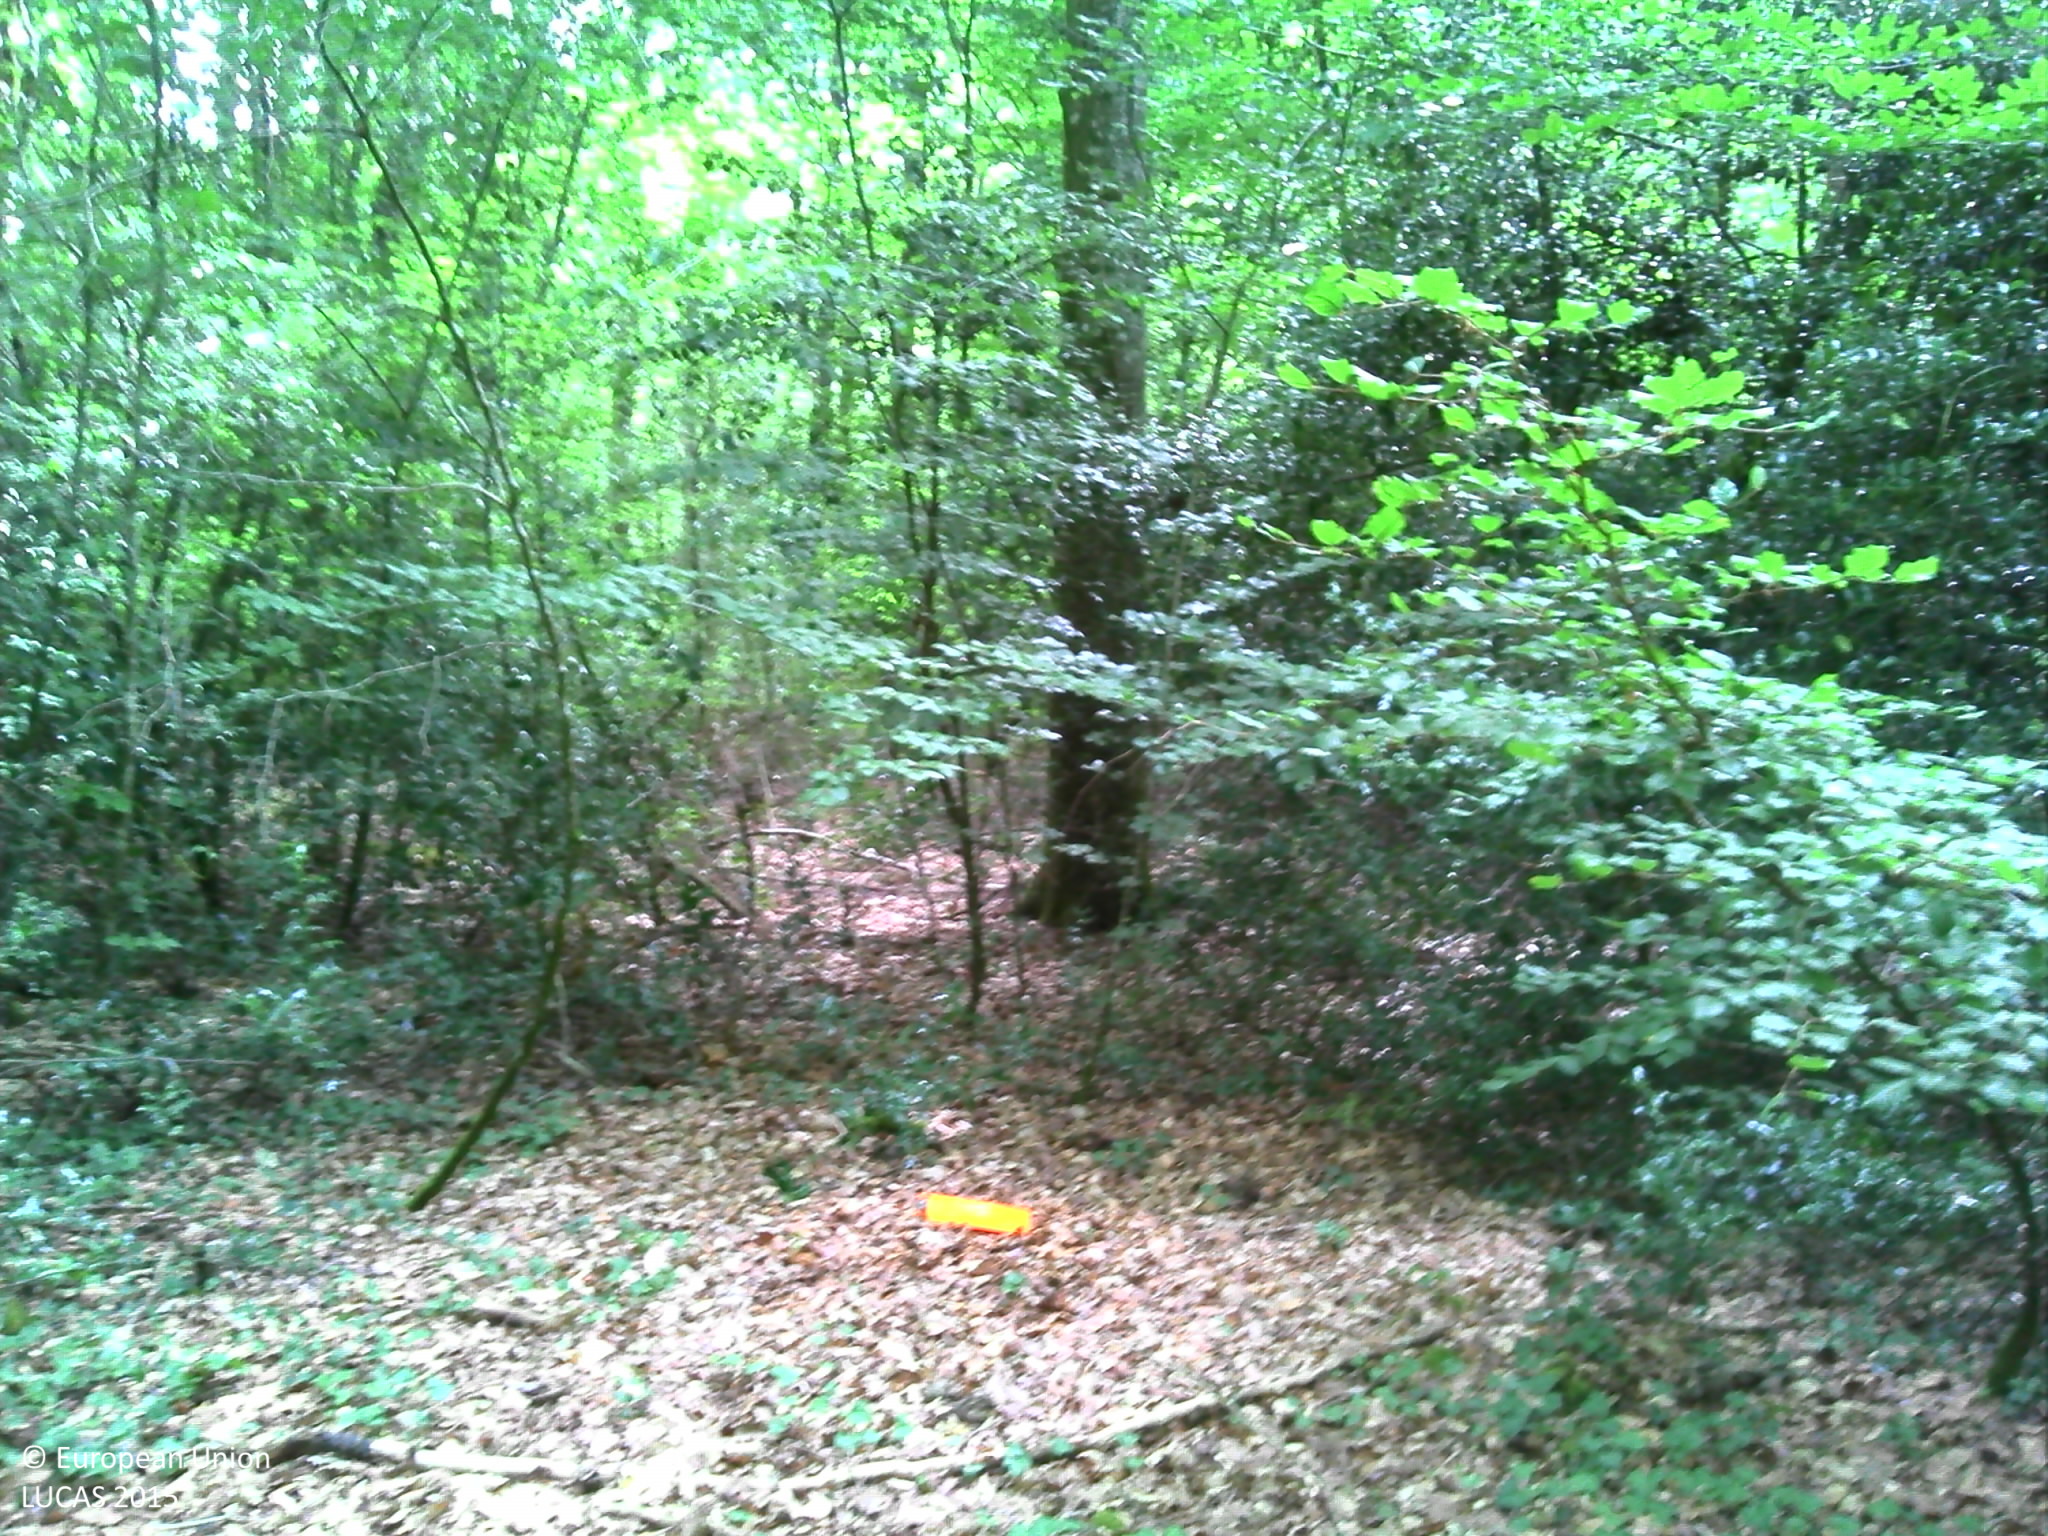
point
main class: Woodland
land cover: Broadleaved woodland
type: acidophilous oak and oak-birch forest
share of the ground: > 75 %
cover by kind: broadleaved forest trees 65 %, herbaceous plants 25 %, shrubs 10 %
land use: Forestry
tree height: > 5 m
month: July
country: FR
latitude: 47.8241
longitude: 0.4261
